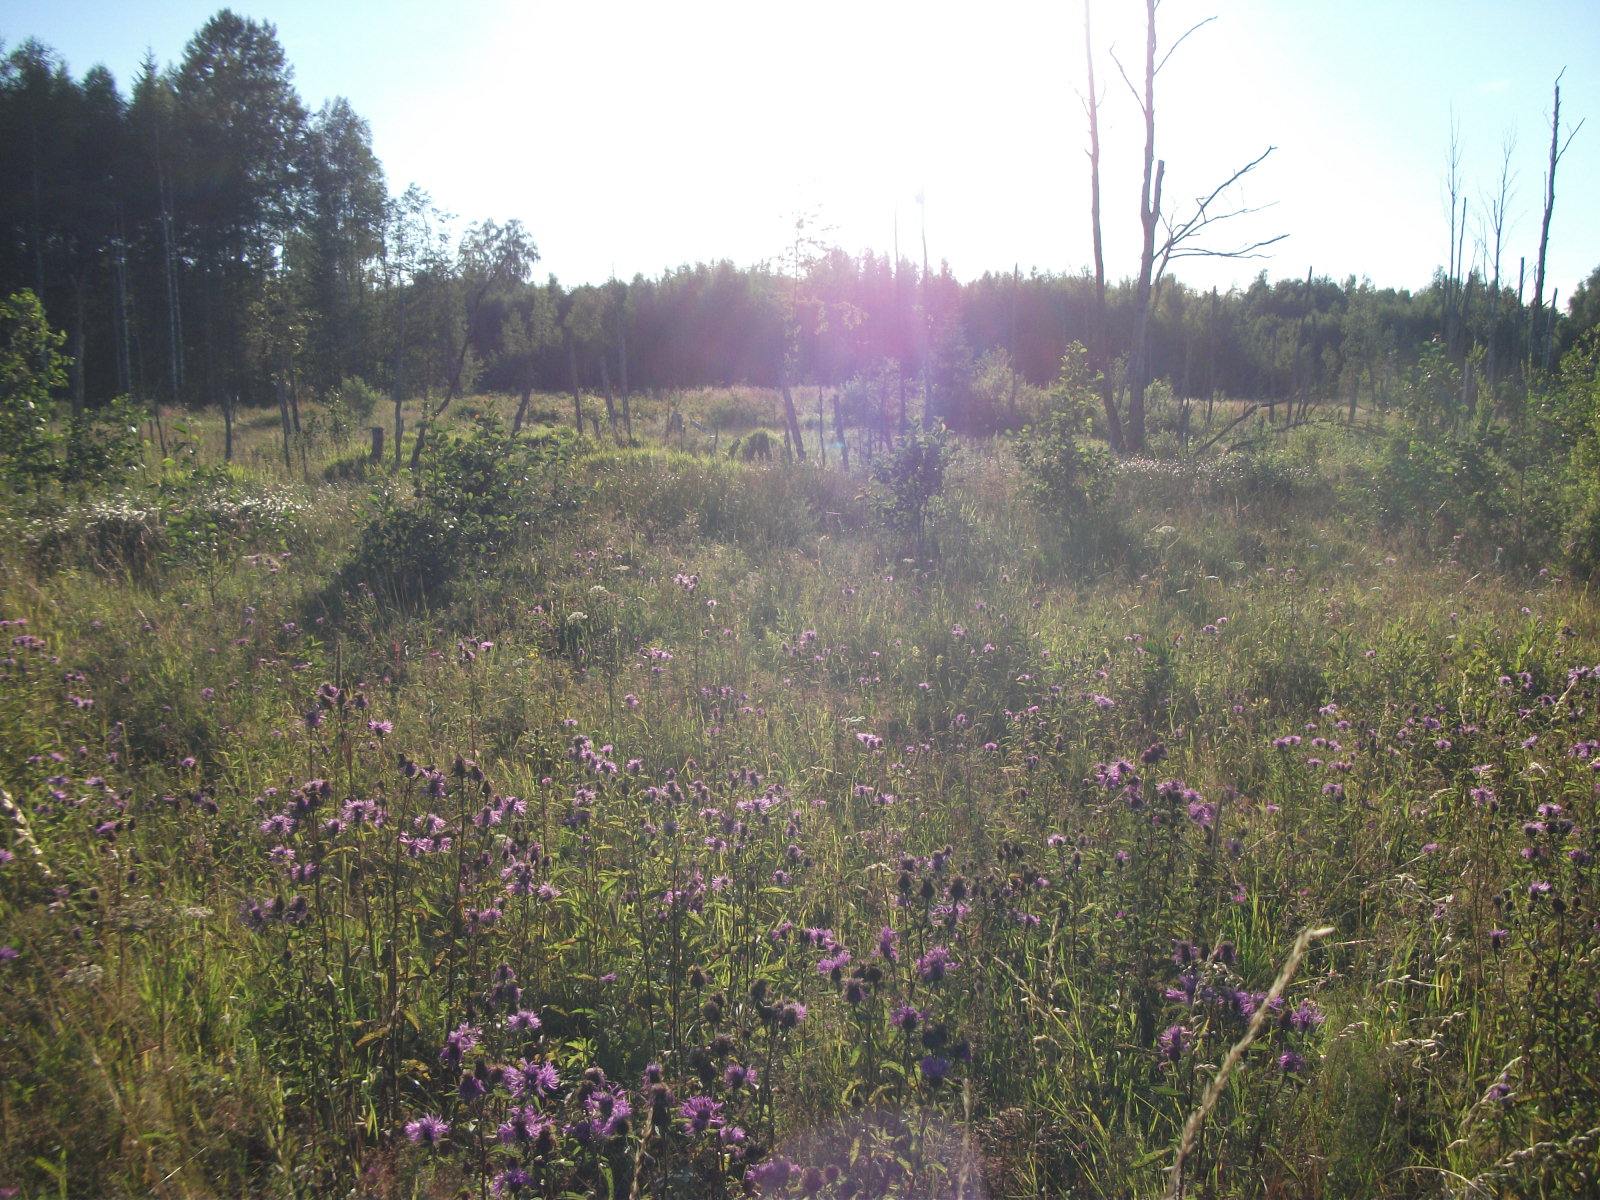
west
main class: Grassland
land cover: Grassland with sparse tree/shrub cover
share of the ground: > 75 %
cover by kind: herbaceous plants 90 %, broadleaved forest trees 5 %, shrubs 5 %
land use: Semi-natural and natural areas not in use
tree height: < 5 m
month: August
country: LV
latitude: 57.0614
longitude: 26.4861
